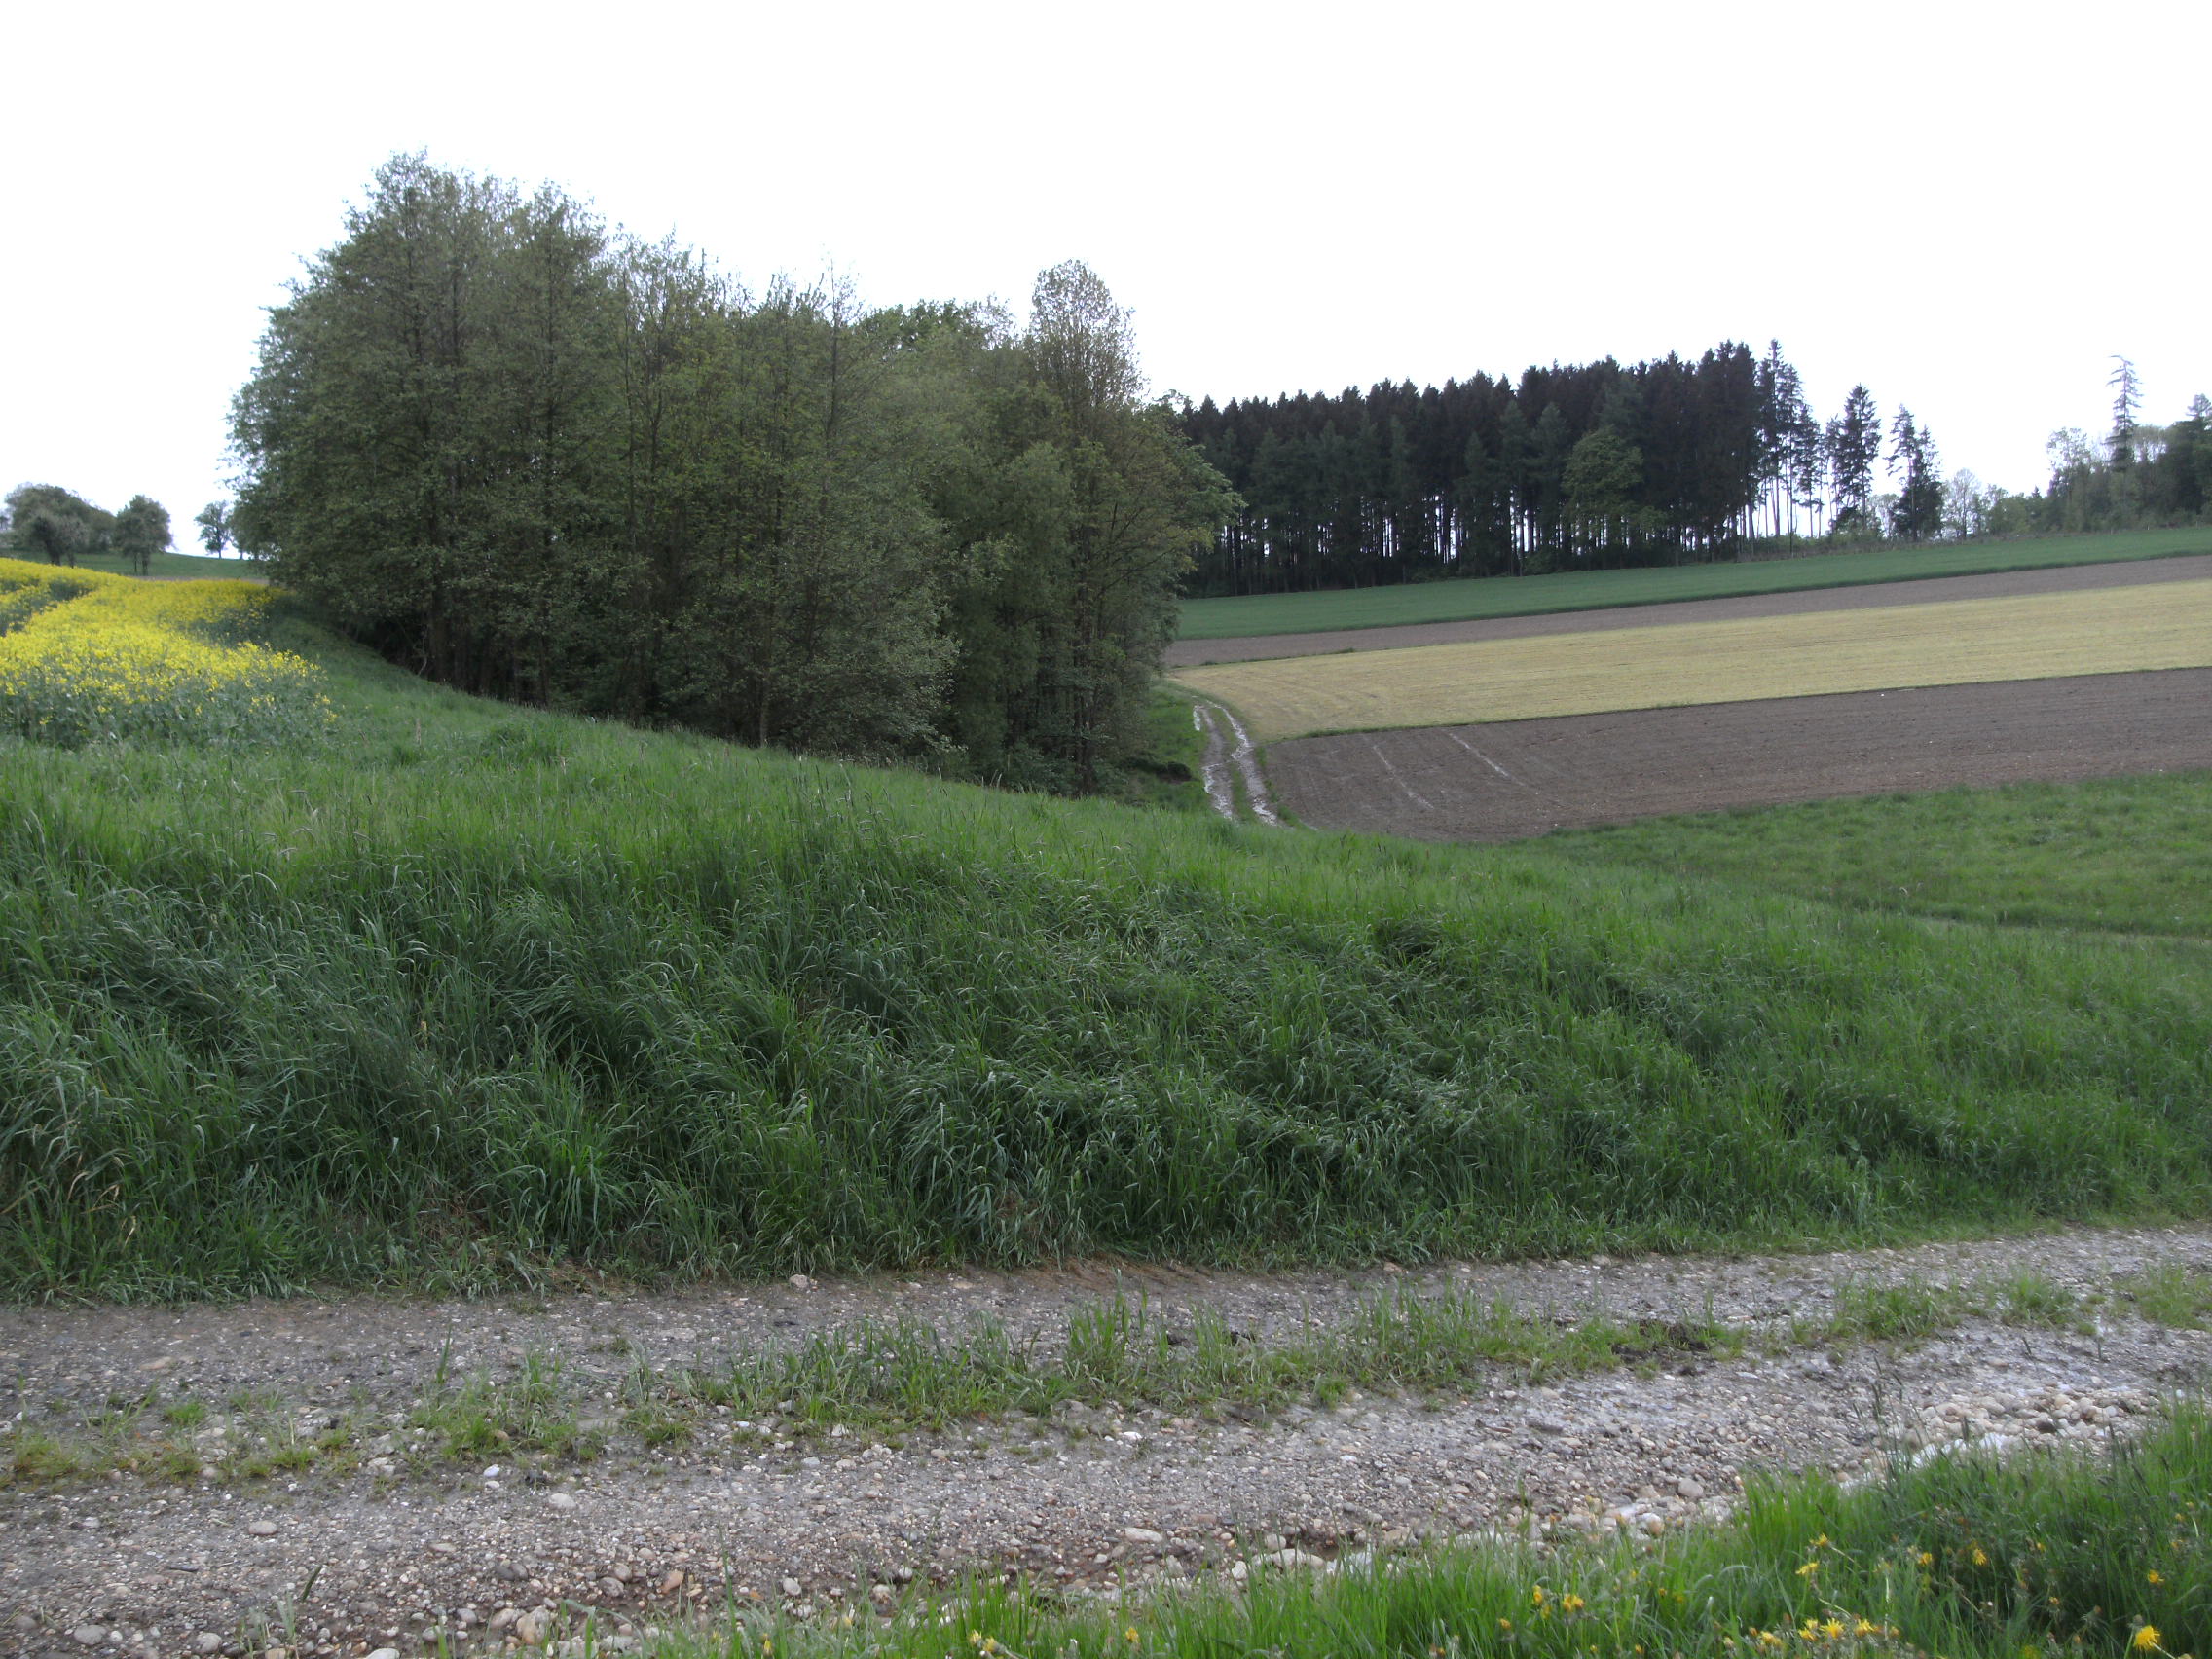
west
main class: Grassland
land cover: Grassland without tree/shrub cover
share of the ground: > 75 %
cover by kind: herbaceous plants 100 %
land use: Agriculture (excluding fallow land and kitchen gardens)
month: May
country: AT
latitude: 48.2585
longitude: 13.4880
